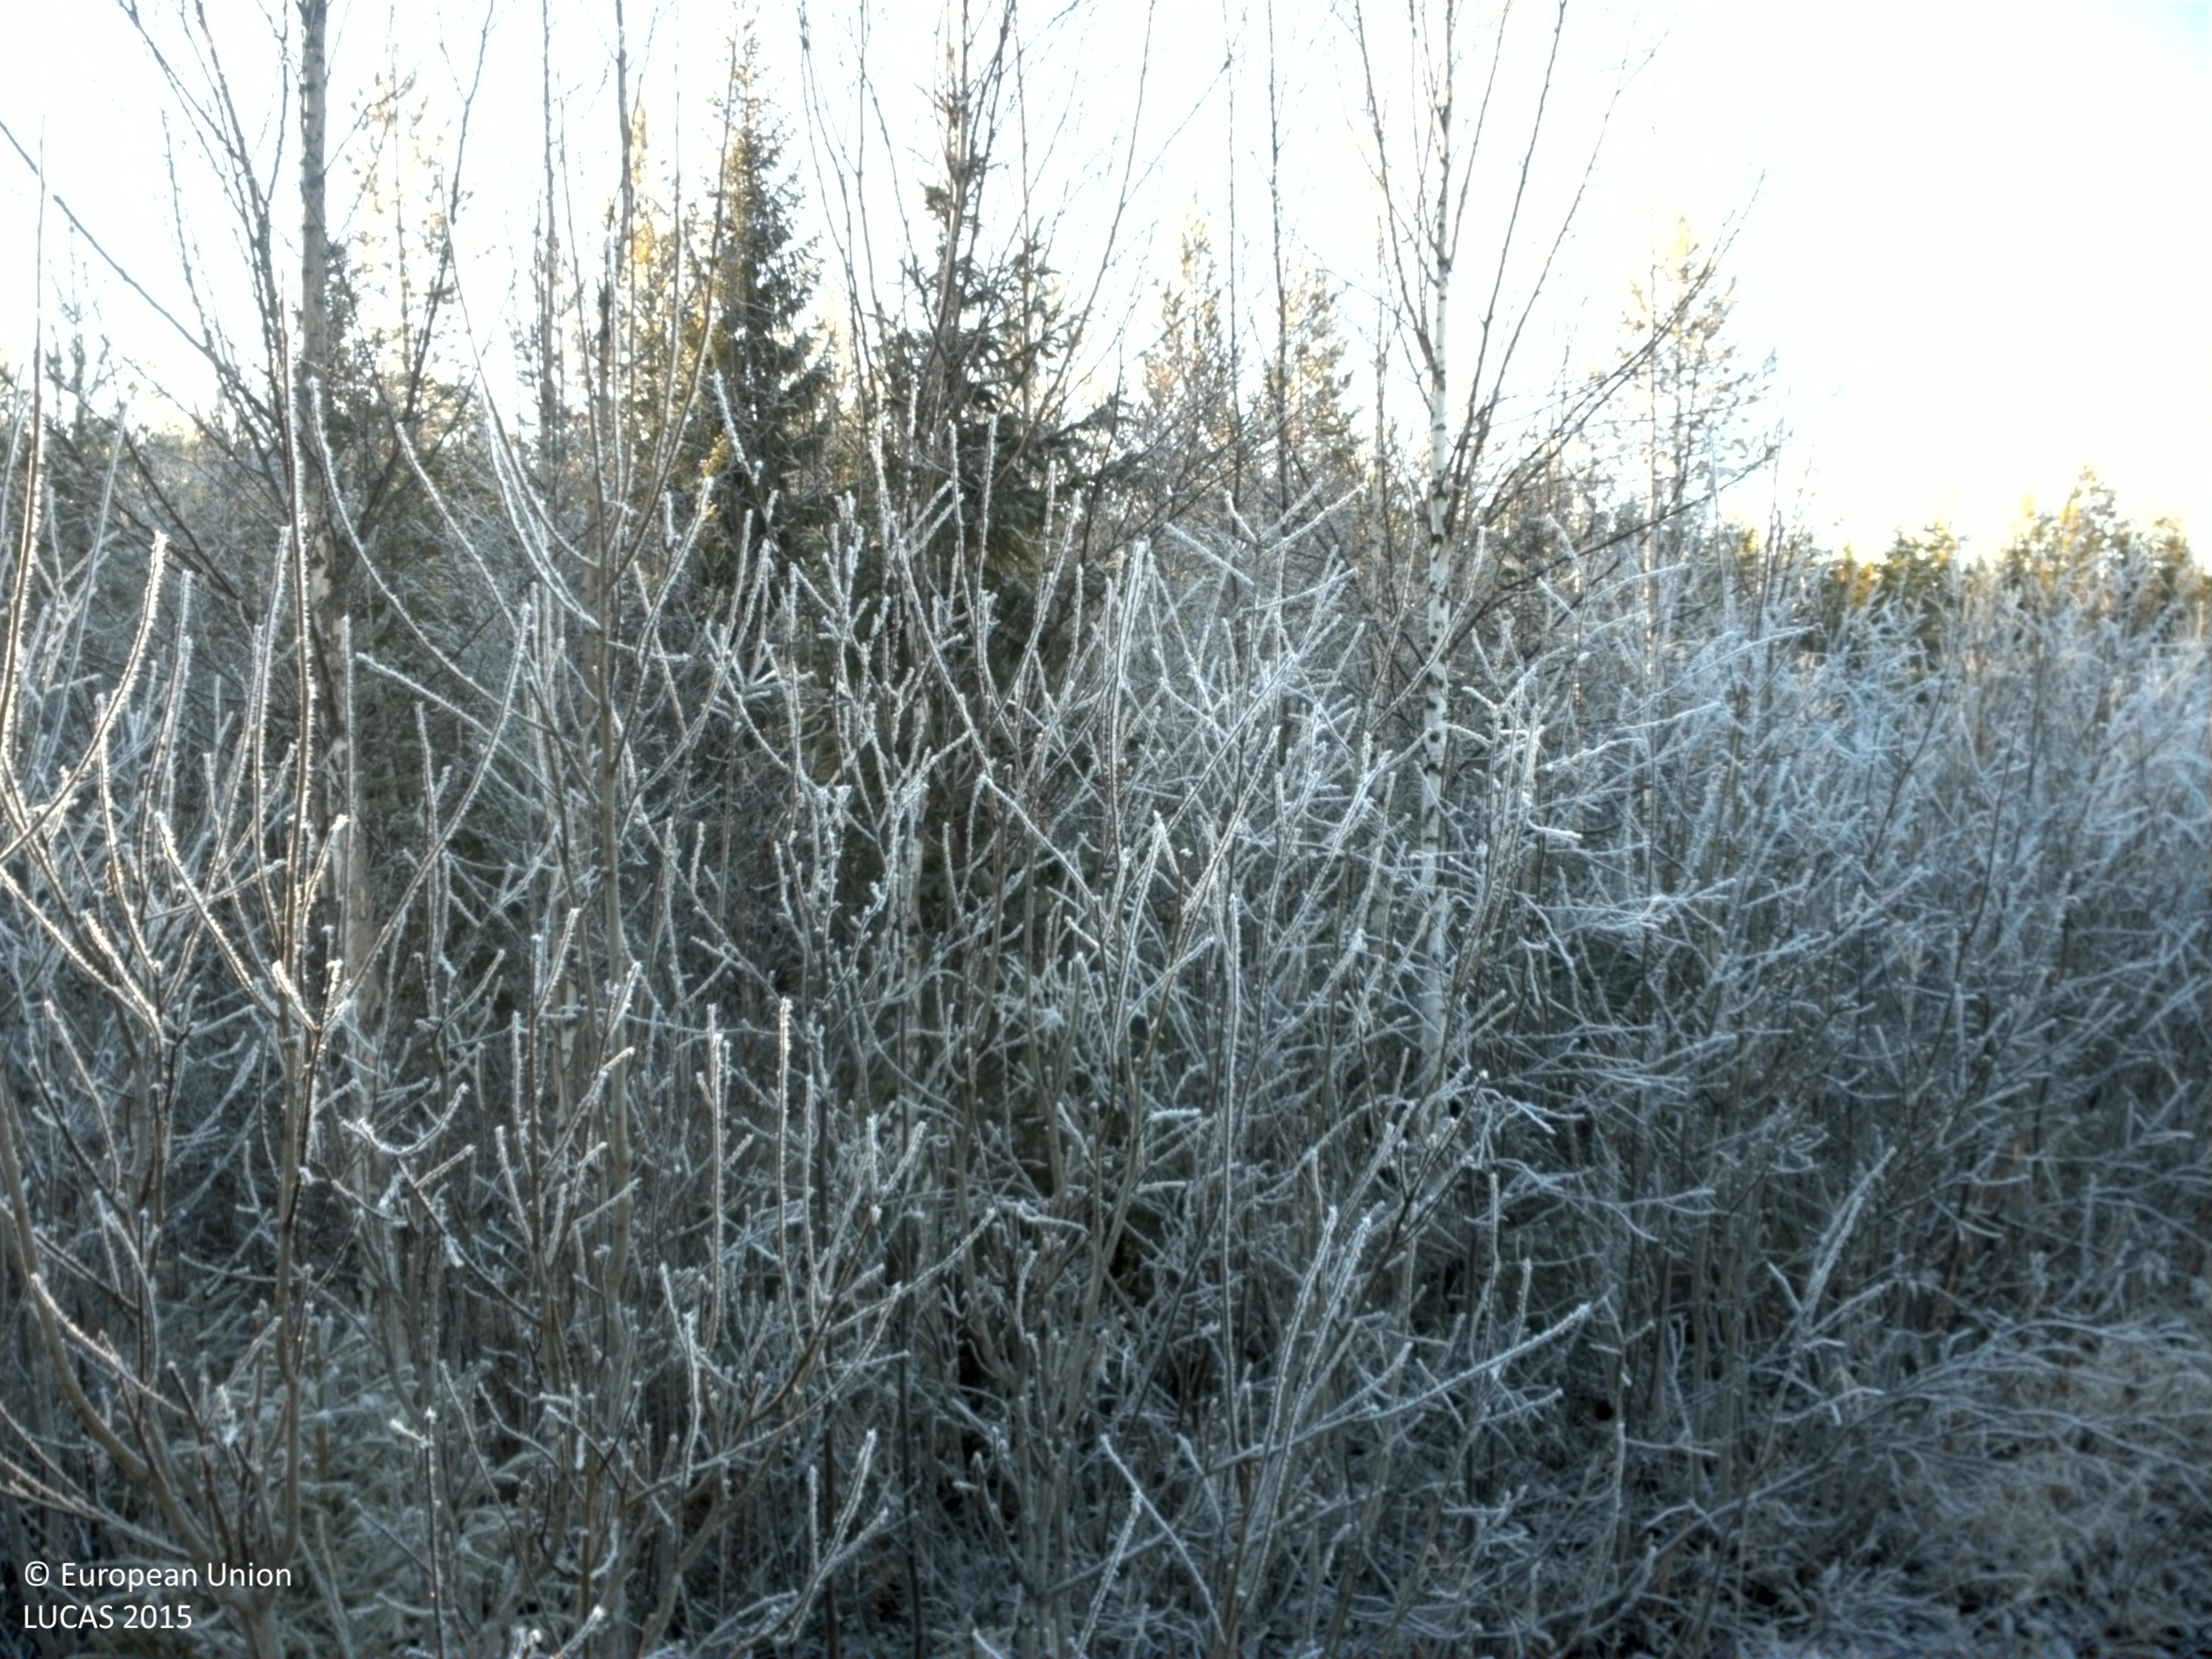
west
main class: Artificial land
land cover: Non built-up linear features
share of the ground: > 75 %
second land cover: Grassland without tree/shrub cover
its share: 10 - 25 %
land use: Road transport
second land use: Forestry
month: October
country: SE
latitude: 64.4406
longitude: 16.6363
